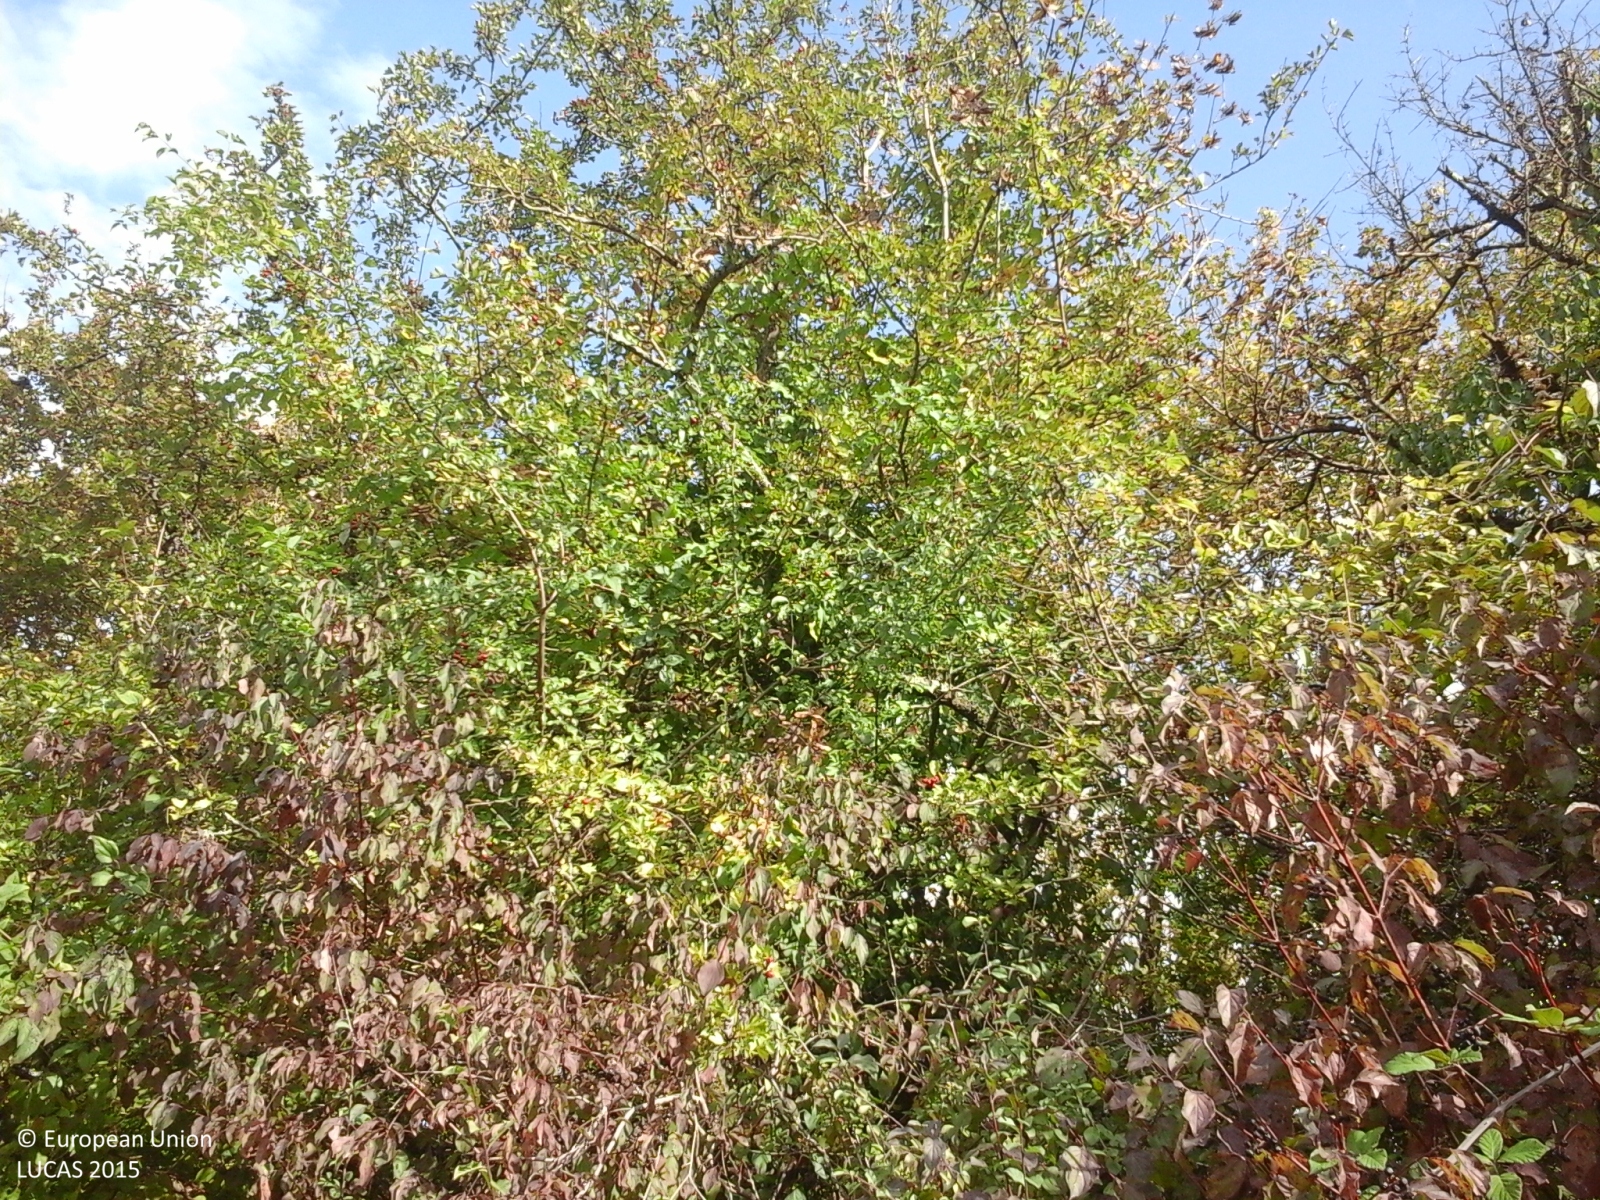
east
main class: Cropland
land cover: Sunflower
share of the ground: < 10 %
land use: Agriculture (excluding fallow land and kitchen gardens)
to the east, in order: Sunflower; Broadleaved woodland; Tracks; Shrubland with sparse tree cover; Broadleaved woodland; Sunflower; Broadleaved woodland
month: October
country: IT
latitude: 43.3148
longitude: 12.2747
